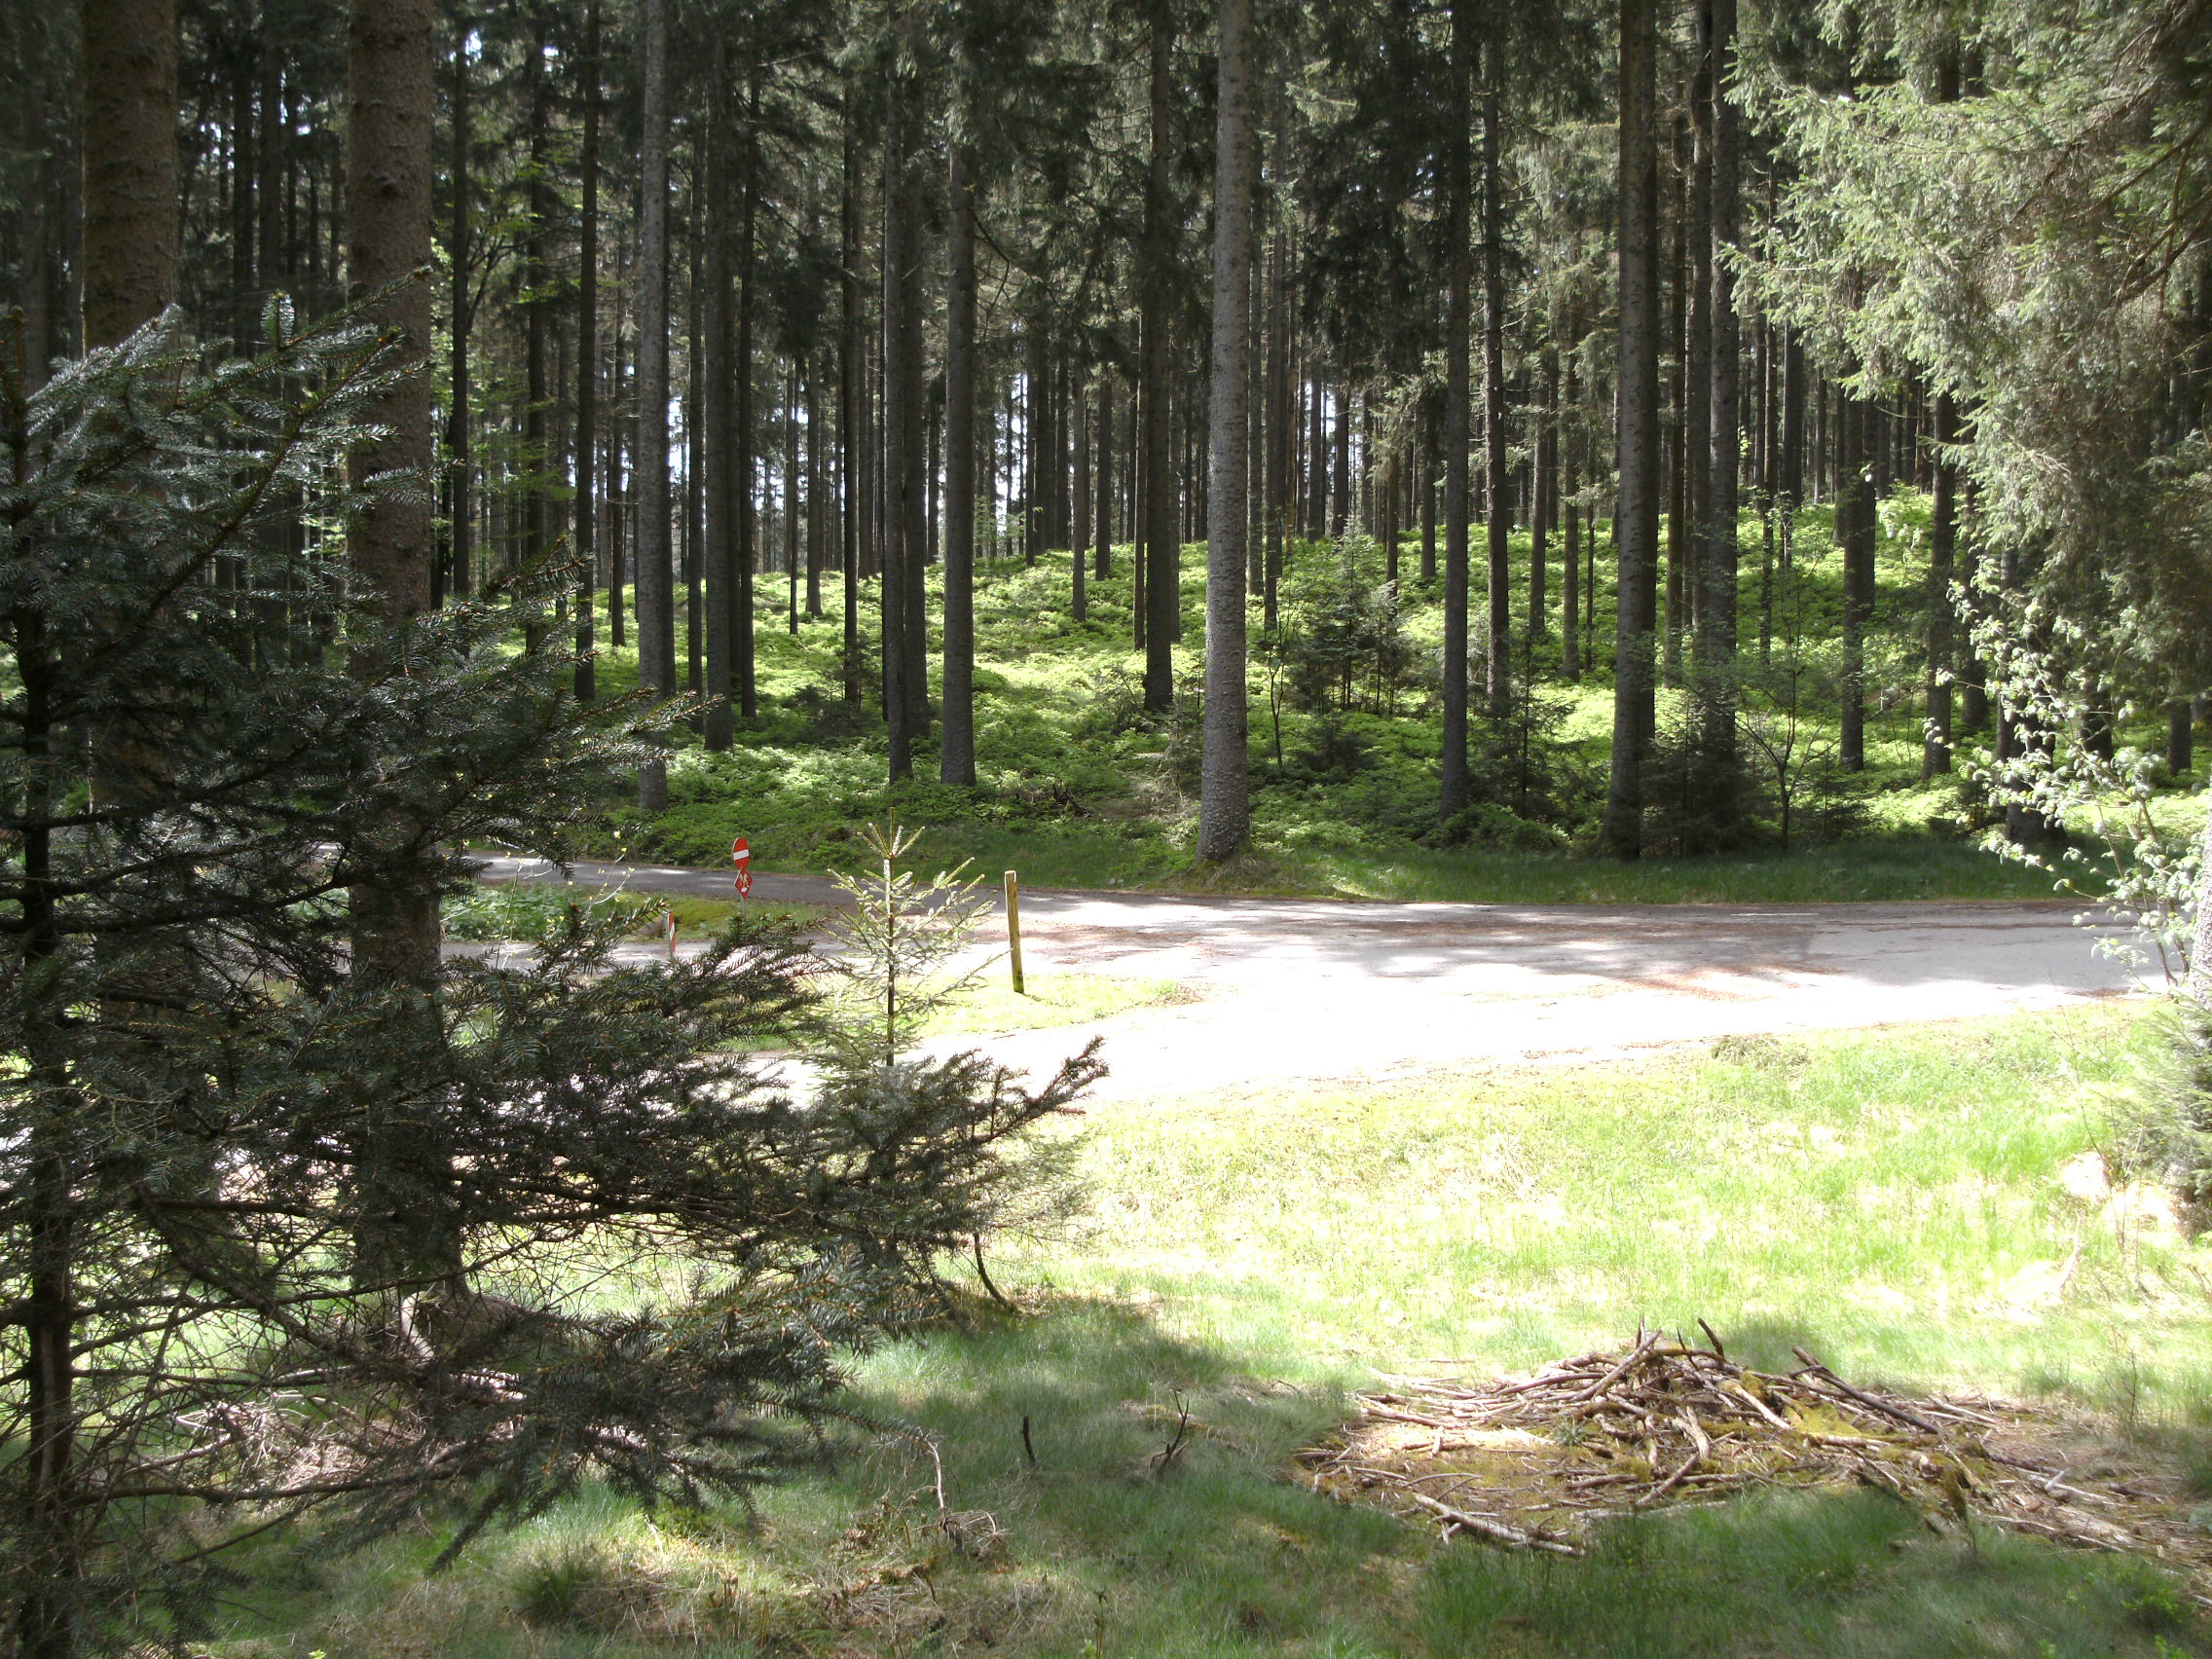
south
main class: Woodland
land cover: Spruce dominated coniferous woodland
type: hemiboreal forest and nemoral coniferous forest and mixed broadleaved-coniferous forest
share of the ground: 50 - 75 %
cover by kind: coniferous forest trees 70 %, herbaceous plants 20 %, shrubs 10 %
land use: Forestry
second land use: Sport
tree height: > 5 m
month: May
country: AT
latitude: 48.1000
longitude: 13.3696
